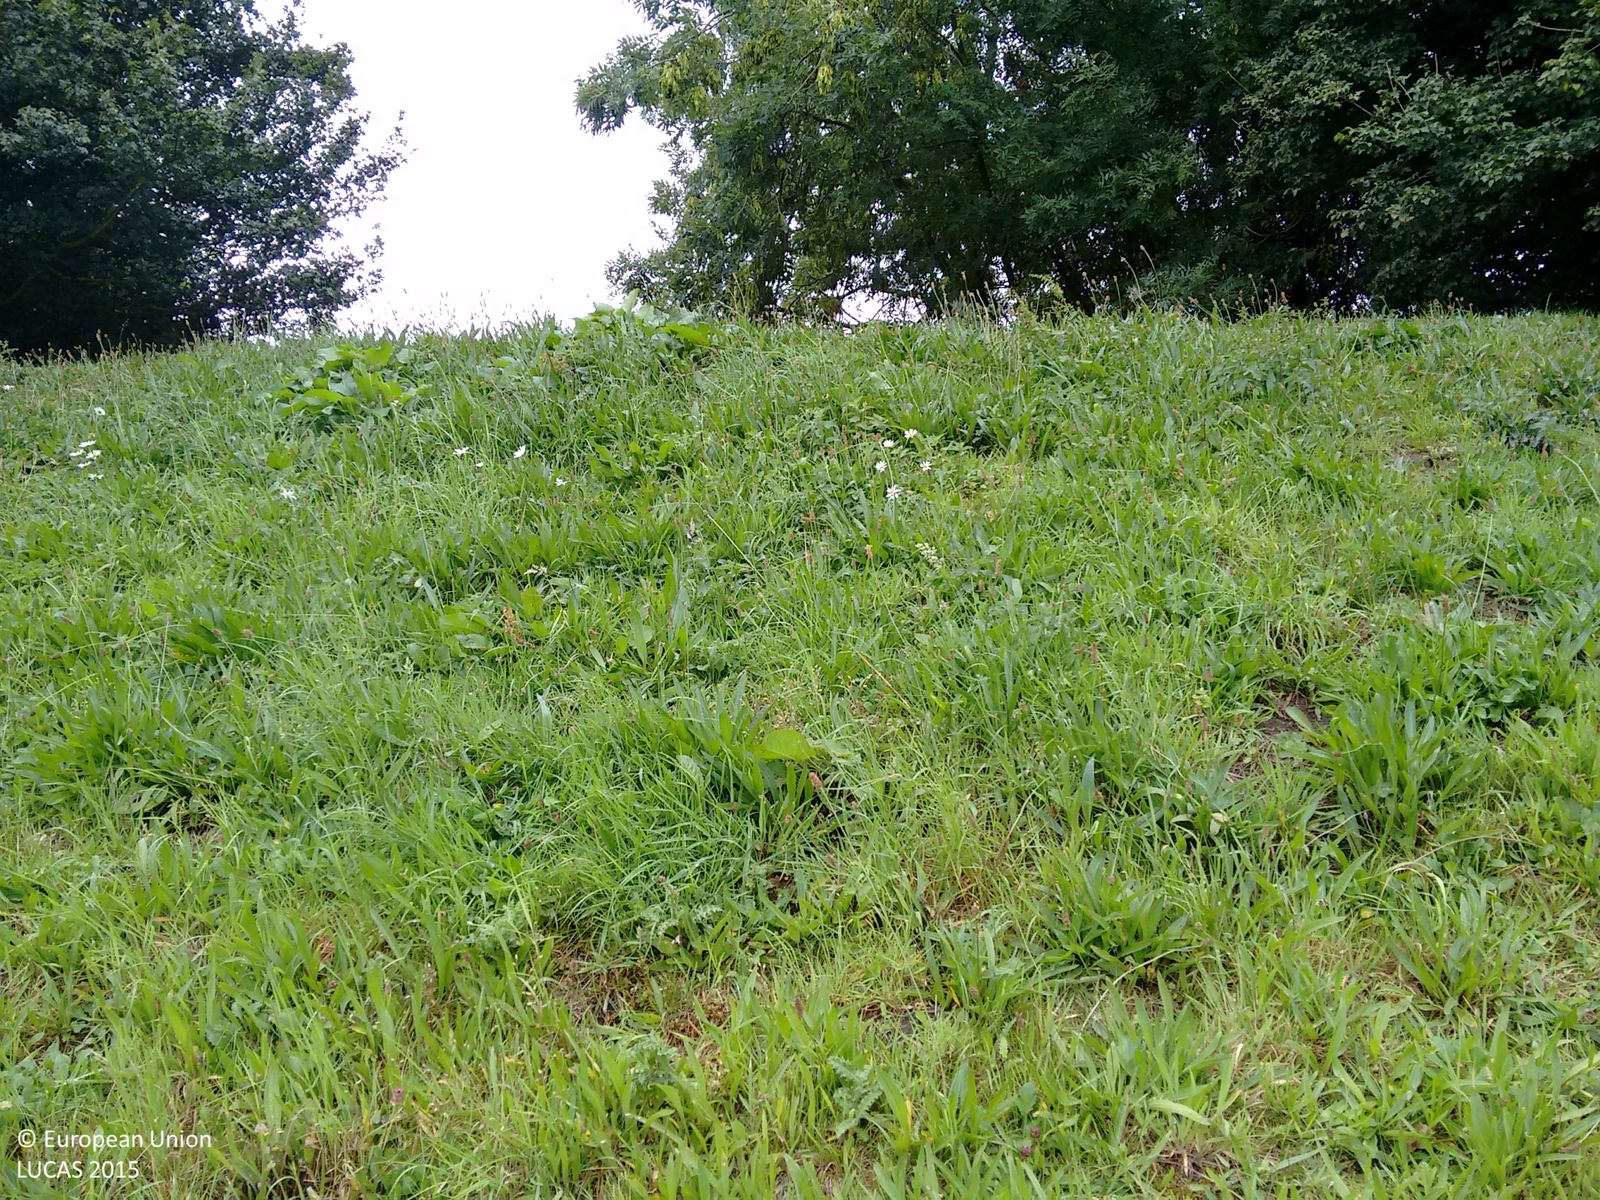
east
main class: Grassland
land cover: Grassland without tree/shrub cover
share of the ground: > 75 %
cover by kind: herbaceous plants 100 %
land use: Logistics and storage
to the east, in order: Grassland without tree/shrub cover; Artificial constructions in urban areas
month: August
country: GB
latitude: 52.7038
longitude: -1.3405
